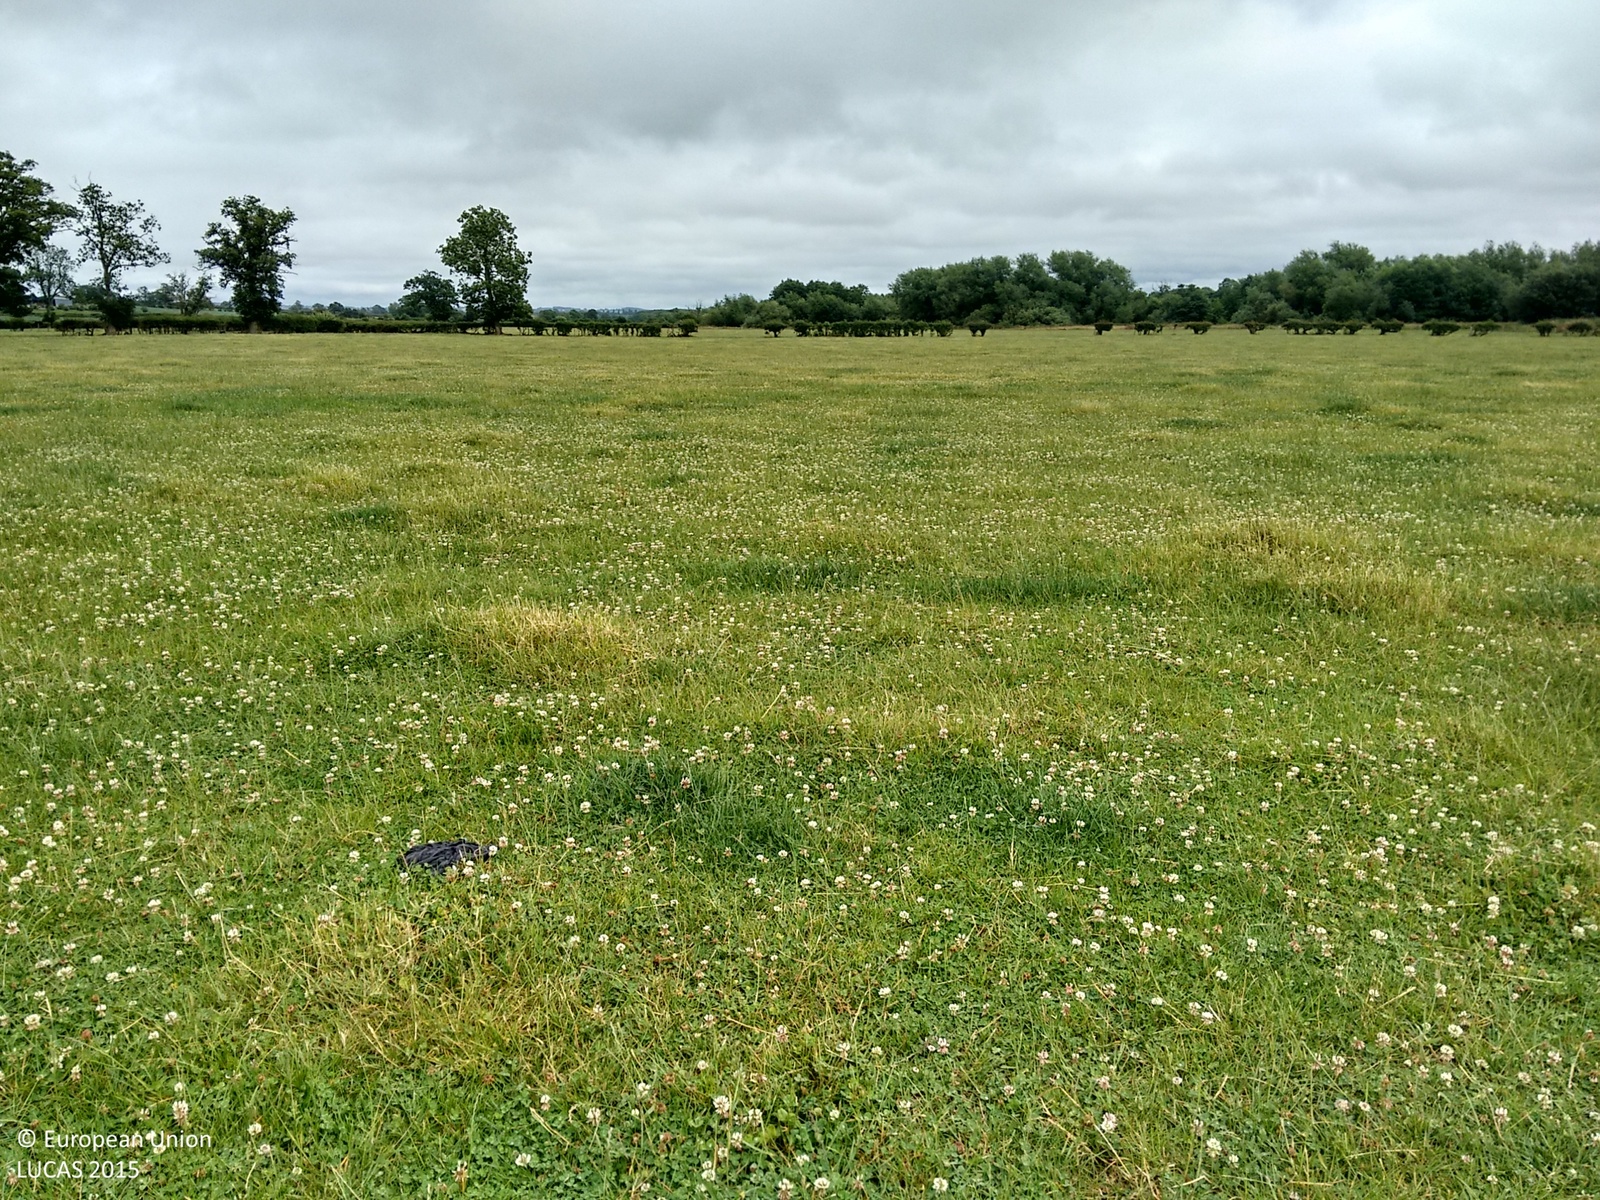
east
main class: Grassland
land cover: Grassland without tree/shrub cover
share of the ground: > 75 %
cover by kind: herbaceous plants 100 %
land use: Agriculture (excluding fallow land and kitchen gardens)
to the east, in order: Grassland without tree/shrub cover; Ditches and canals; Managed hedges; Grassland without tree/shrub cover
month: July
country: GB
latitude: 52.2248
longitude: -2.8228
